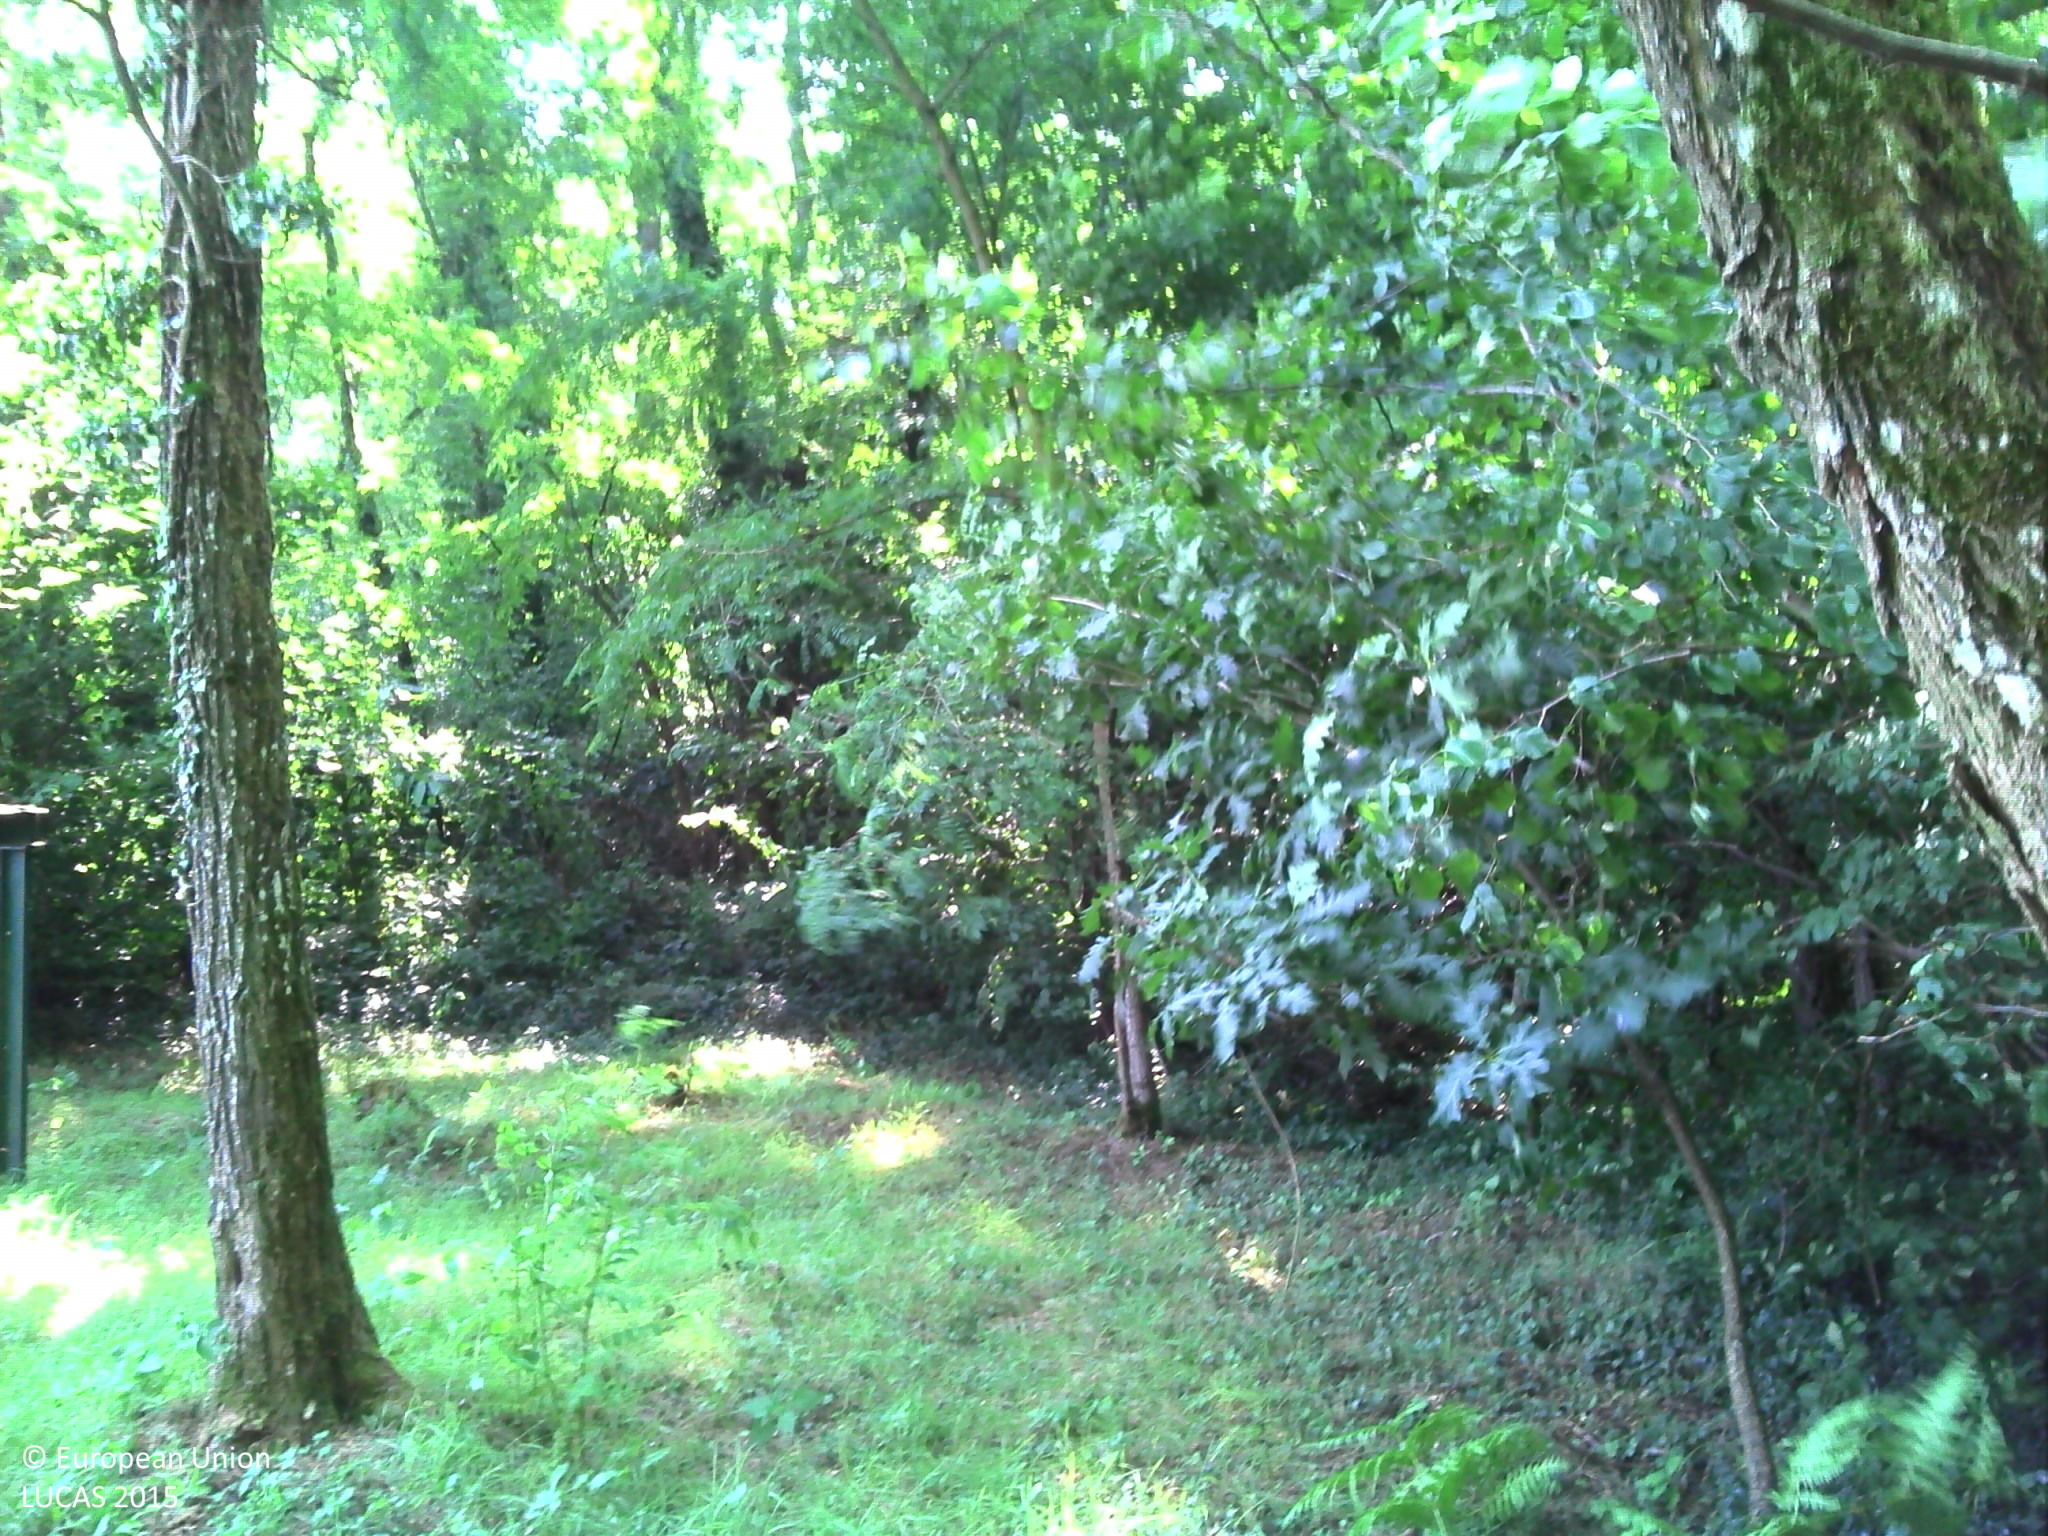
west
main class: Woodland
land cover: Broadleaved woodland
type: mesophytic deciduous forest
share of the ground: > 75 %
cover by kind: broadleaved forest trees 100 %
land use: Forestry
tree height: > 5 m
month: July
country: FR
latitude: 45.6219
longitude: 5.4257
